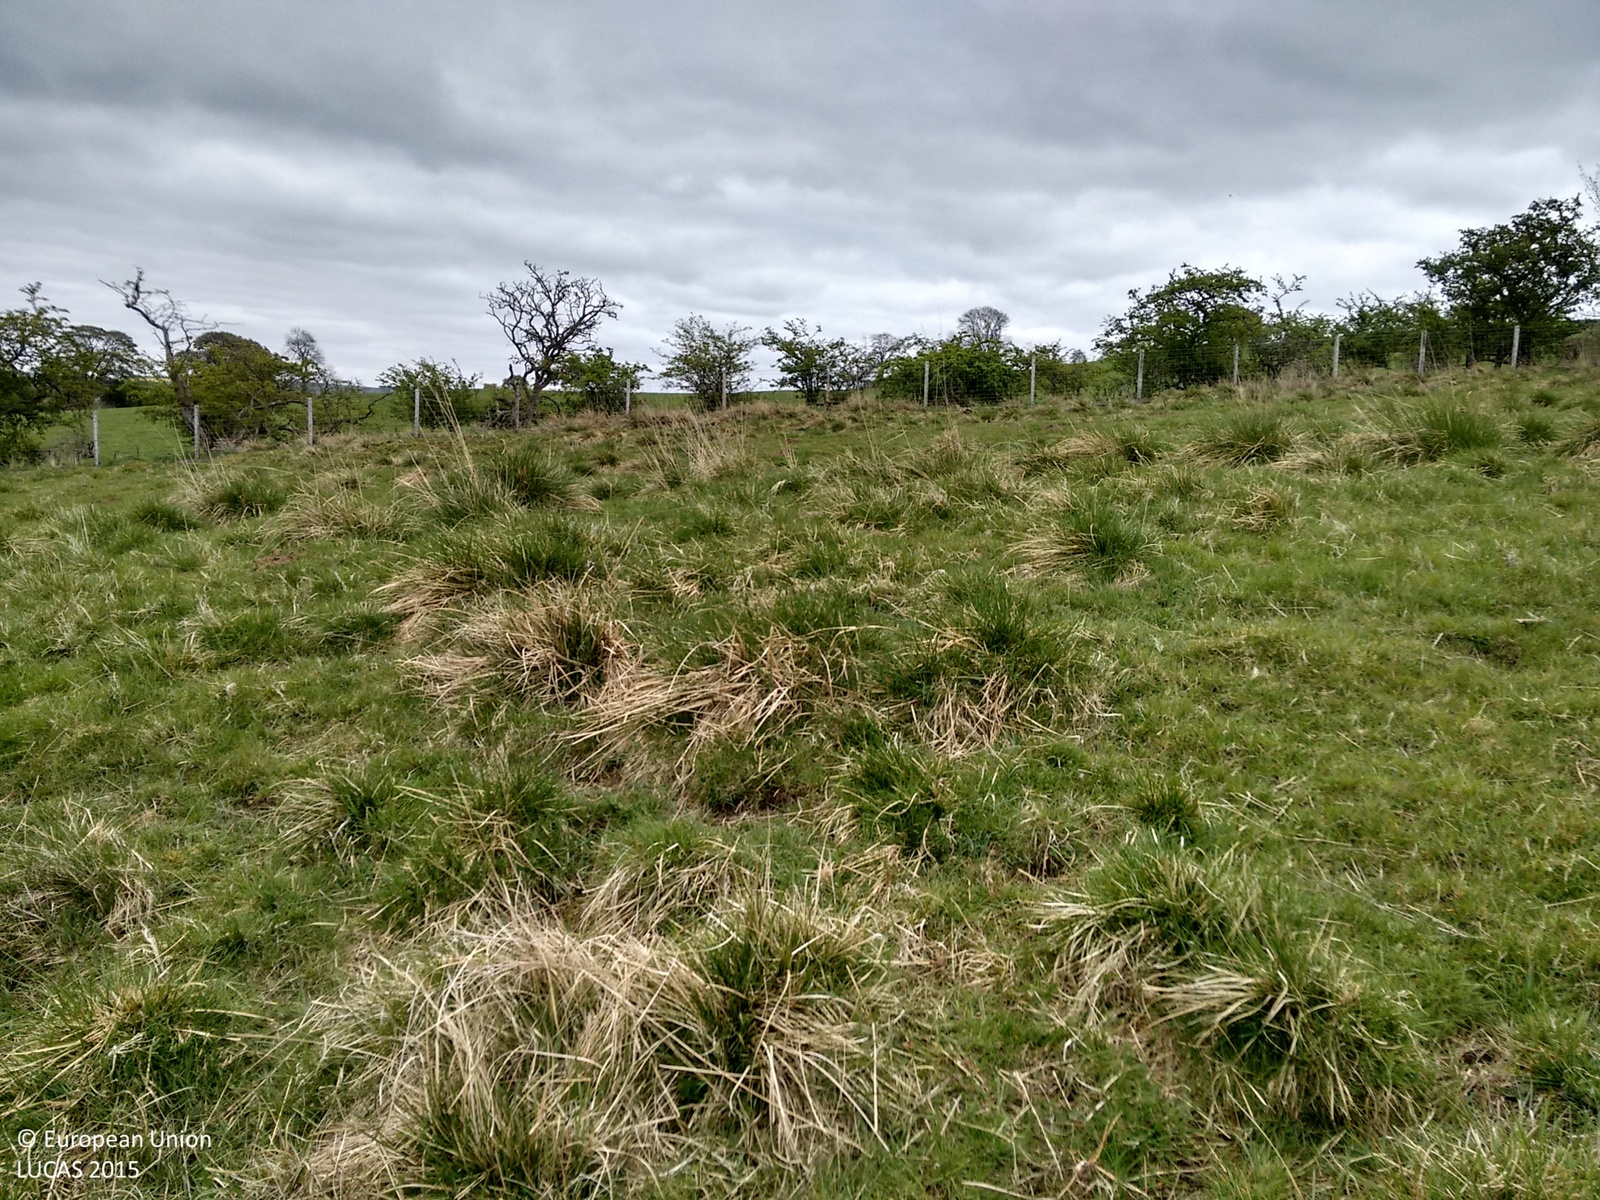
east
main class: Grassland
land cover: Grassland without tree/shrub cover
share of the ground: > 75 %
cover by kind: herbaceous plants 100 %
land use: Agriculture (excluding fallow land and kitchen gardens)
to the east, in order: Grassland without tree/shrub cover; Fences; Abandoned hedges; Grassland without tree/shrub cover; Fences; Abandoned hedges; Tracks; Abandoned hedges; Fences; Grassland without tree/shrub cover
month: May
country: GB
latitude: 55.0315
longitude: -2.0870
